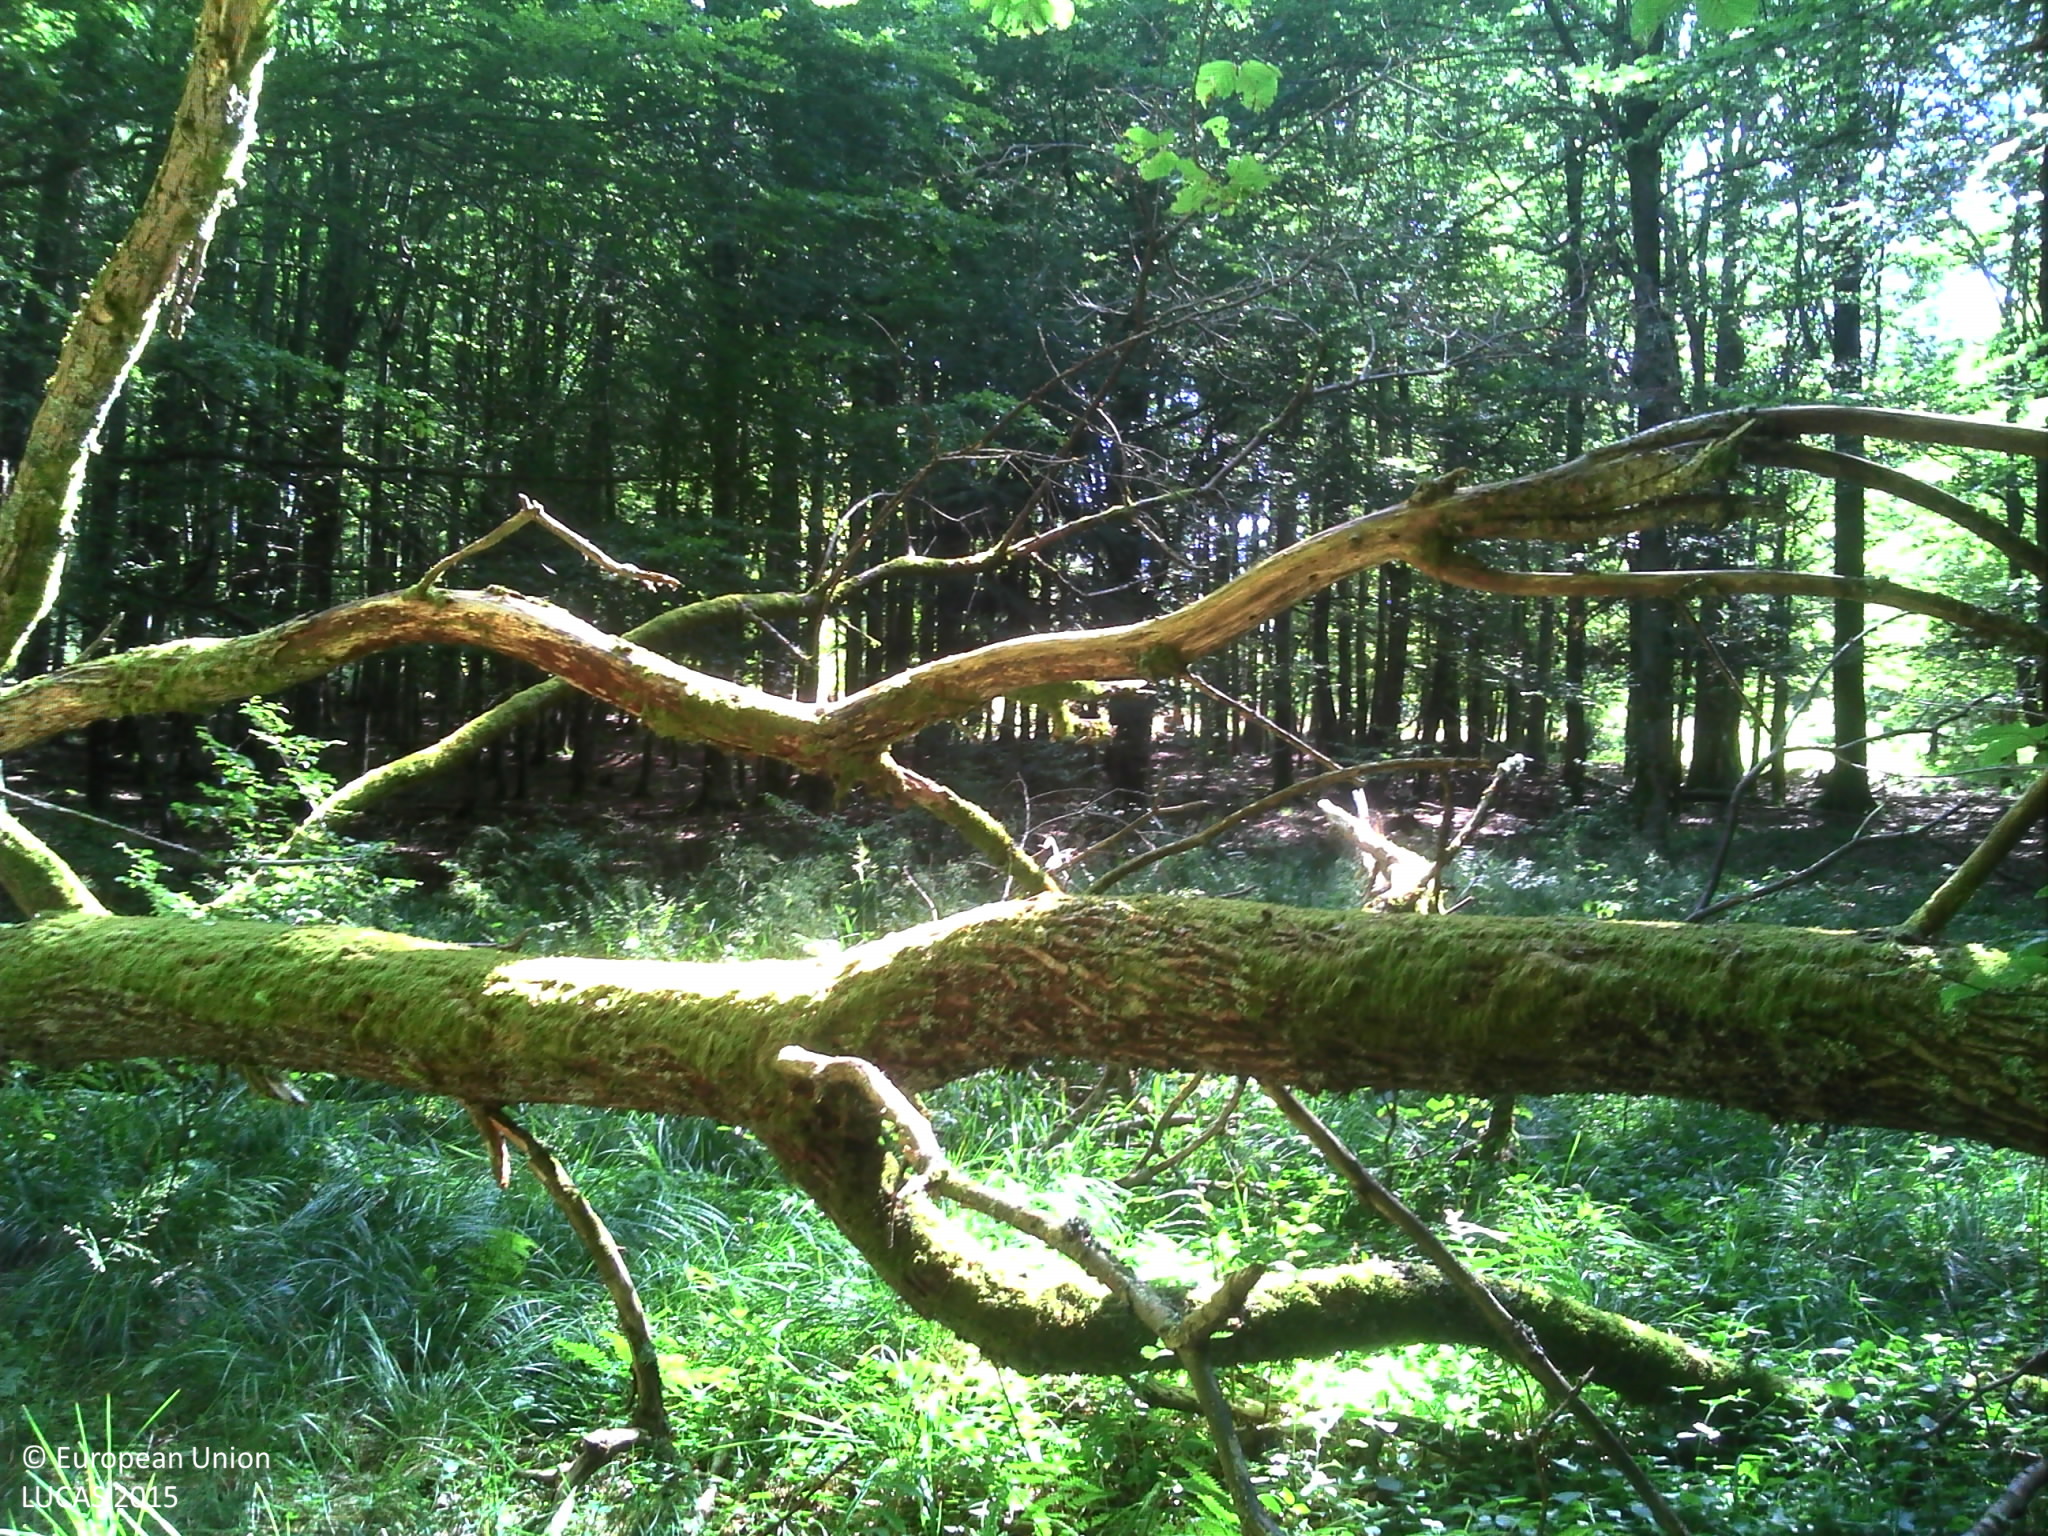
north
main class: Woodland
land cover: Spruce dominated mixed woodland
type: mountainous beech forest
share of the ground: > 75 %
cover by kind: coniferous forest trees 60 %, broadleaved forest trees 35 %, herbaceous plants 5 %
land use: Forestry
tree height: > 5 m
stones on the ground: < 10 %
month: July
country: FR
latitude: 48.4614
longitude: 7.3367
